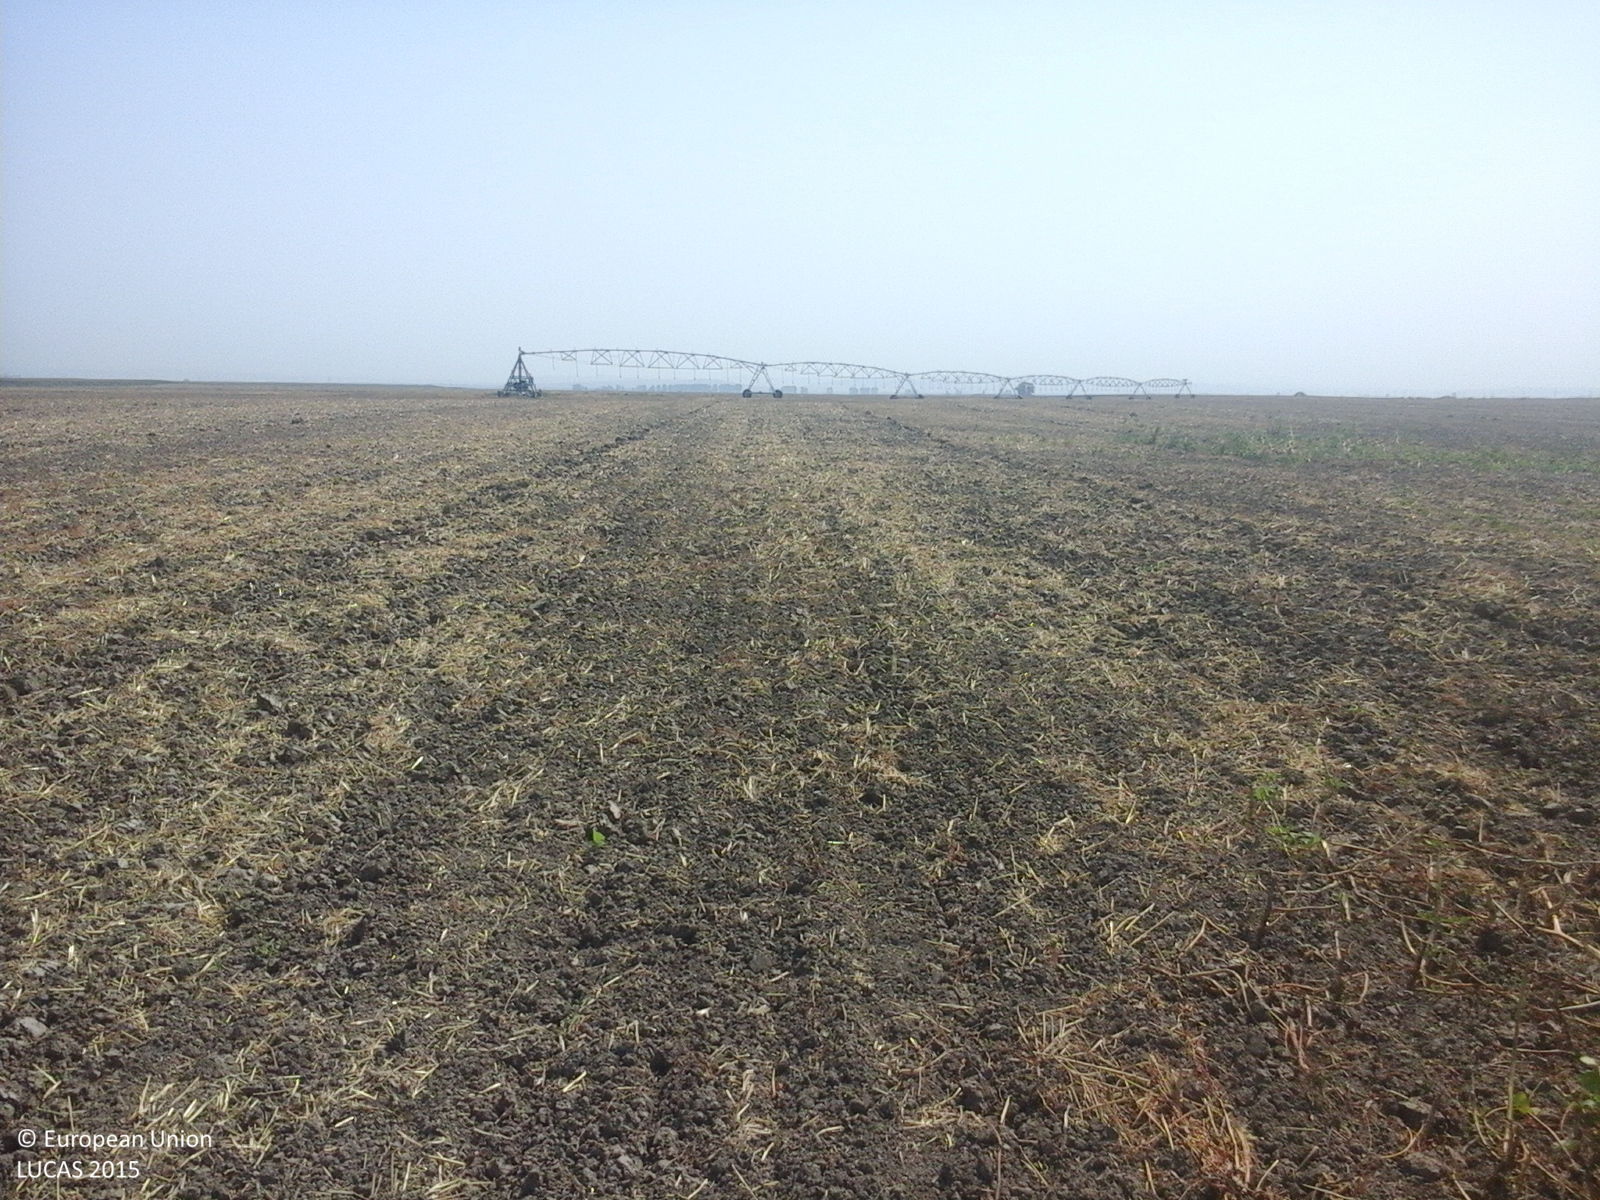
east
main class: Cropland
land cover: Common wheat
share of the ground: < 10 %
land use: Agriculture (excluding fallow land and kitchen gardens)
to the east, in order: Common wheat
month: August
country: RO
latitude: 44.9991
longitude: 27.9603
